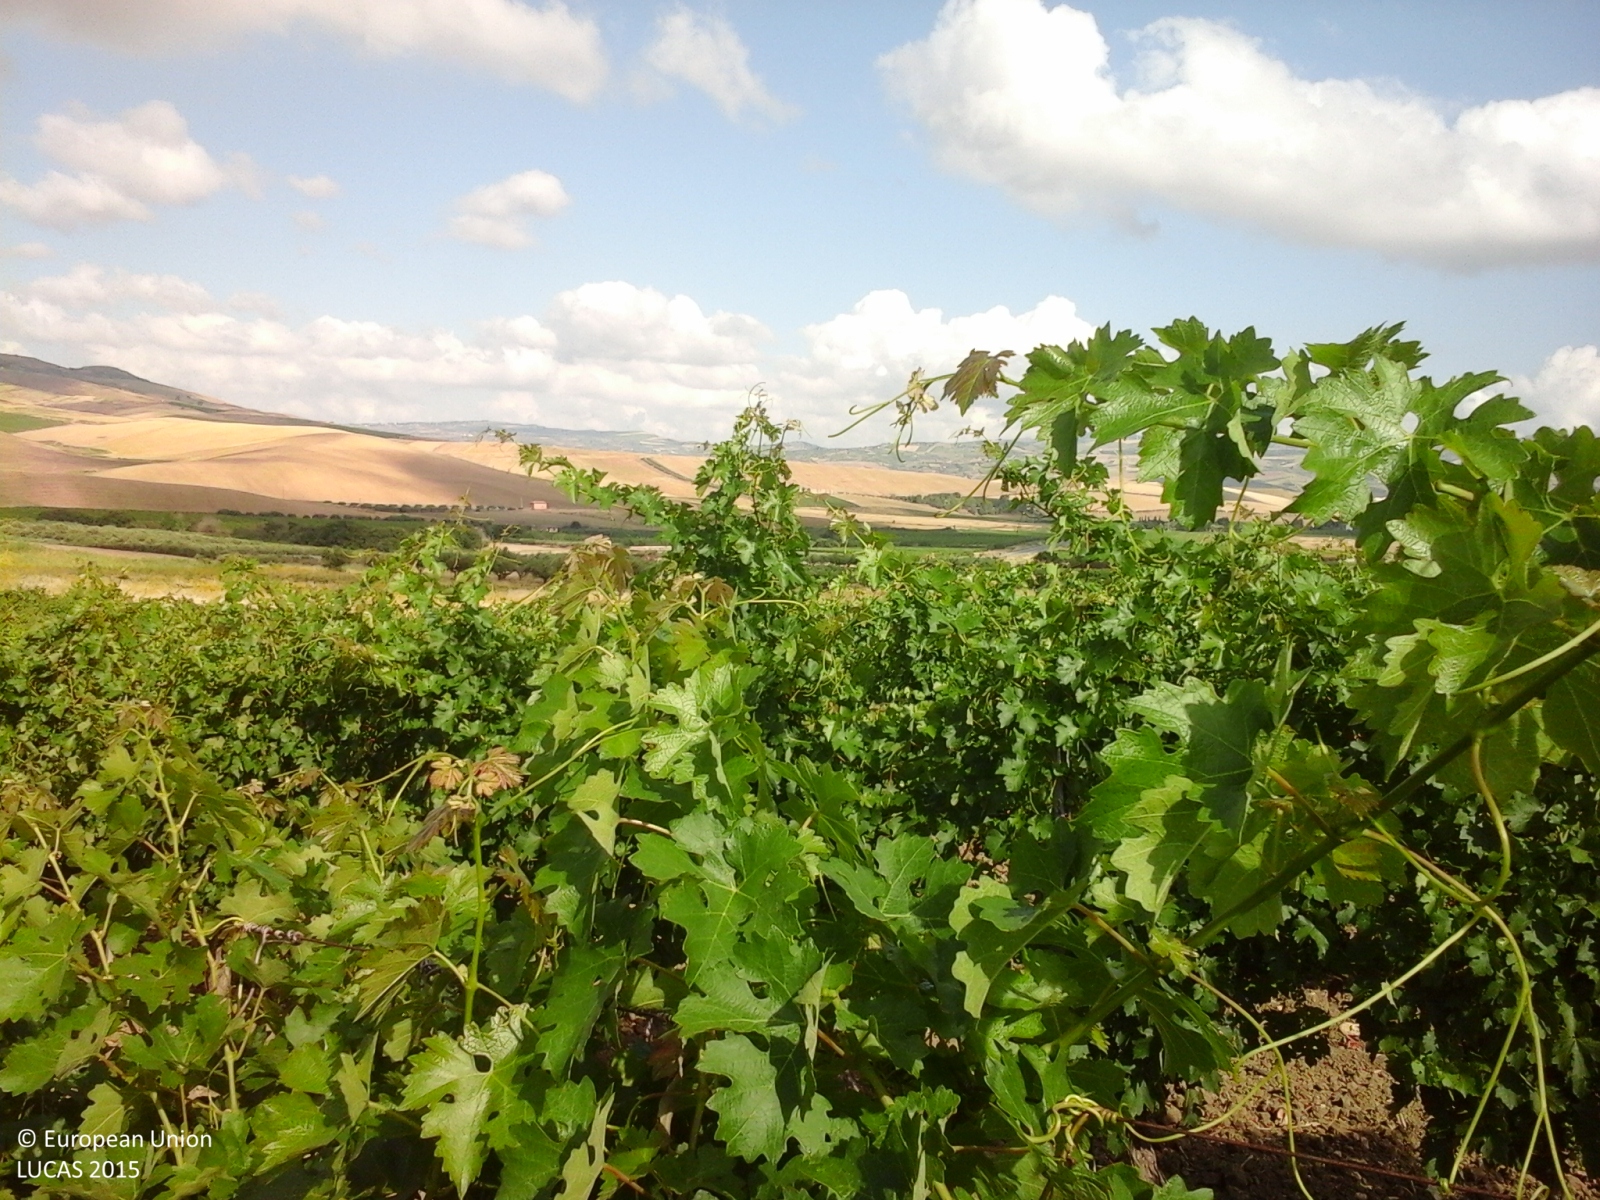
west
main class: Cropland
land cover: Vineyards
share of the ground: 50 - 75 %
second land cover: Other bare soil
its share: > 75 %
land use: Agriculture (excluding fallow land and kitchen gardens)
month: June
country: IT
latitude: 37.7168
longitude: 13.0515
